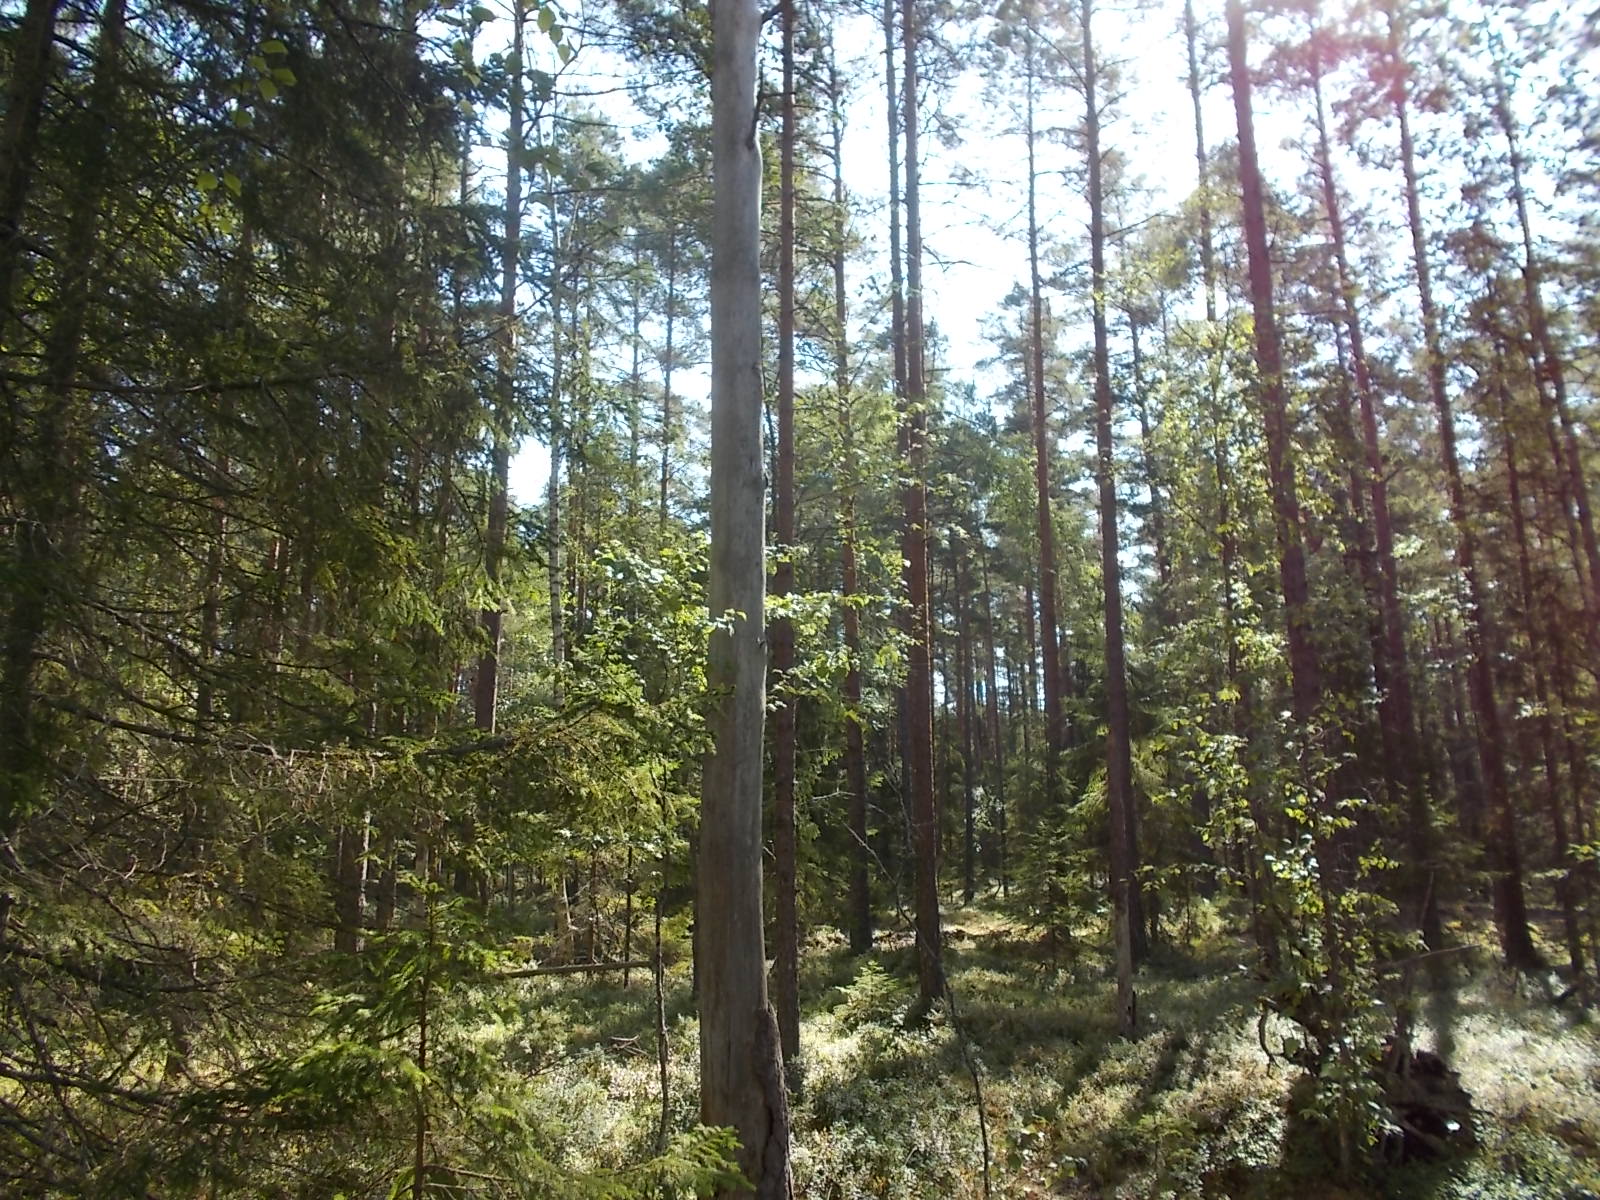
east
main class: Woodland
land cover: Other coniferous woodland
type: hemiboreal forest and nemoral coniferous forest and mixed broadleaved-coniferous forest
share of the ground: 50 - 75 %
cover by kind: coniferous forest trees 60 %, broadleaved forest trees 10 %, shrubs 10 %, herbaceous plants 10 %, lichens and mosses 10 %
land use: Forestry
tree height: > 5 m
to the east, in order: Other coniferous woodland
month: August
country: LV
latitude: 57.0631
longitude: 21.9693
